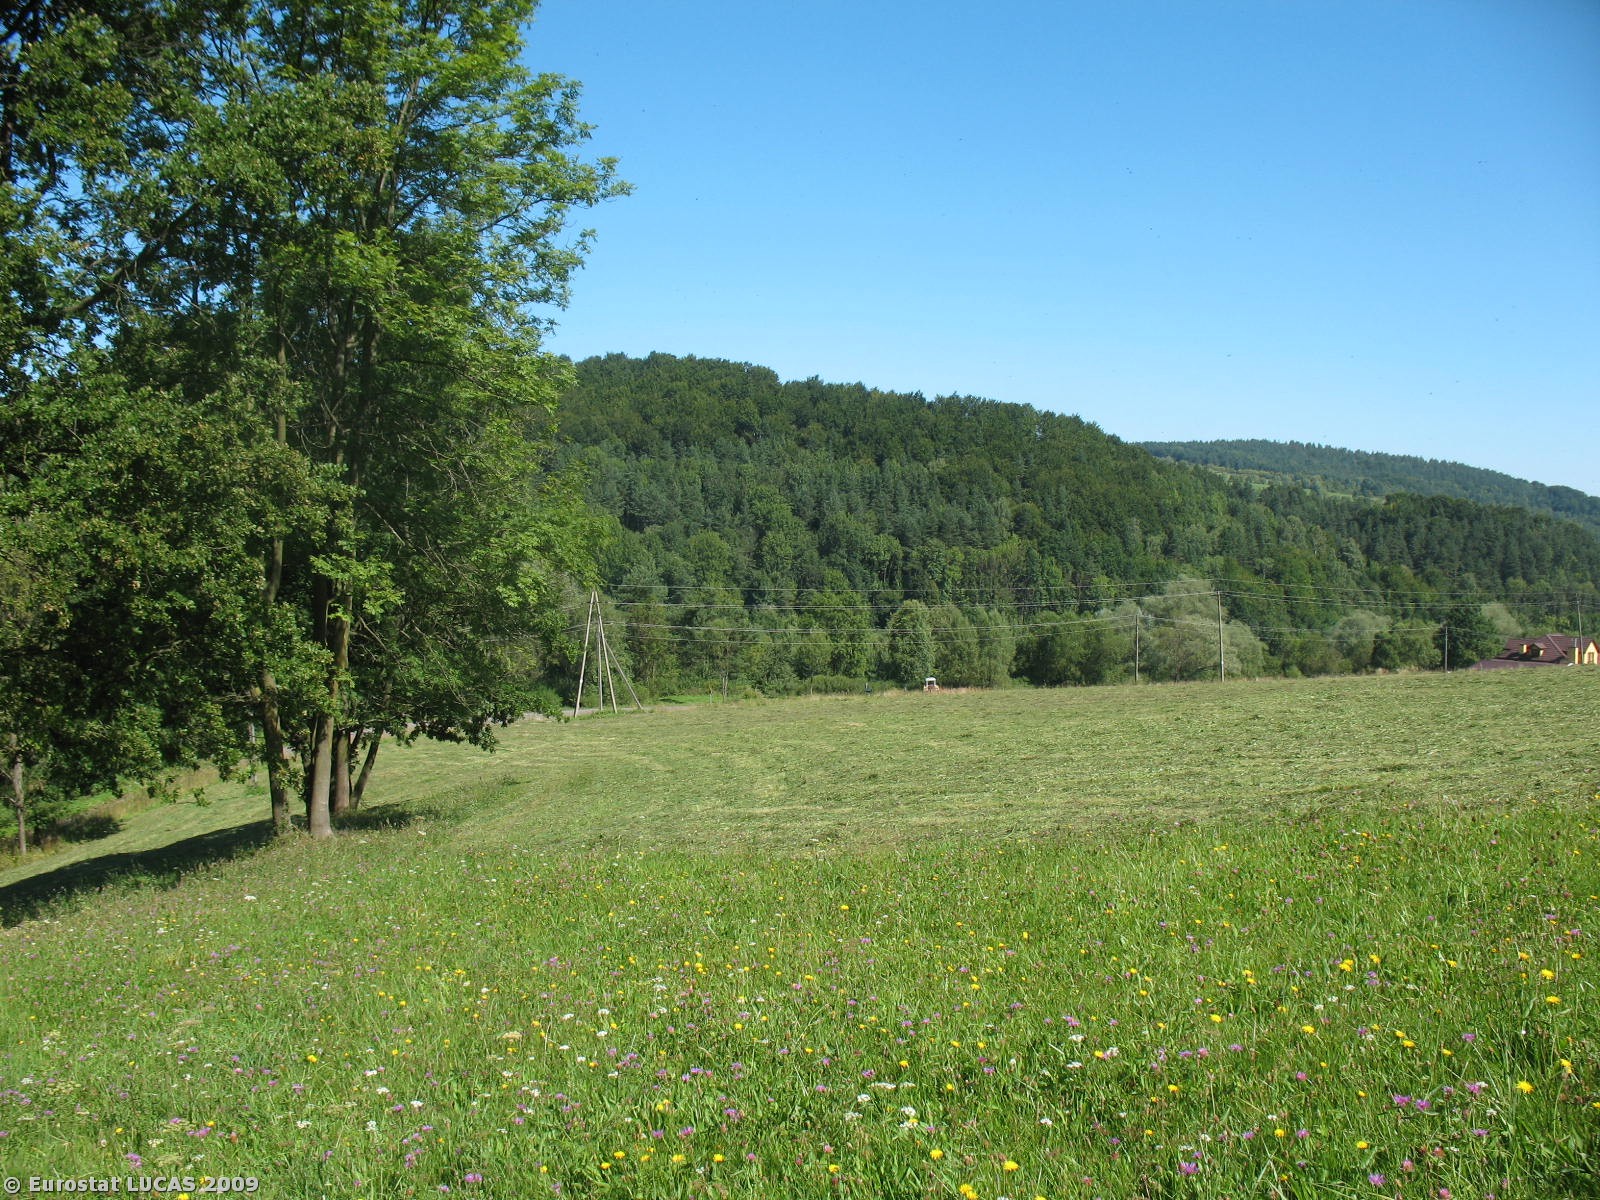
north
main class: Grassland
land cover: Grassland without tree/shrub cover
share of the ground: > 75 %
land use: Agriculture (excluding fallow land and kitchen gardens)
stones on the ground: < 10 %
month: August
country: PL
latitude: 49.3812
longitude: 22.1947
